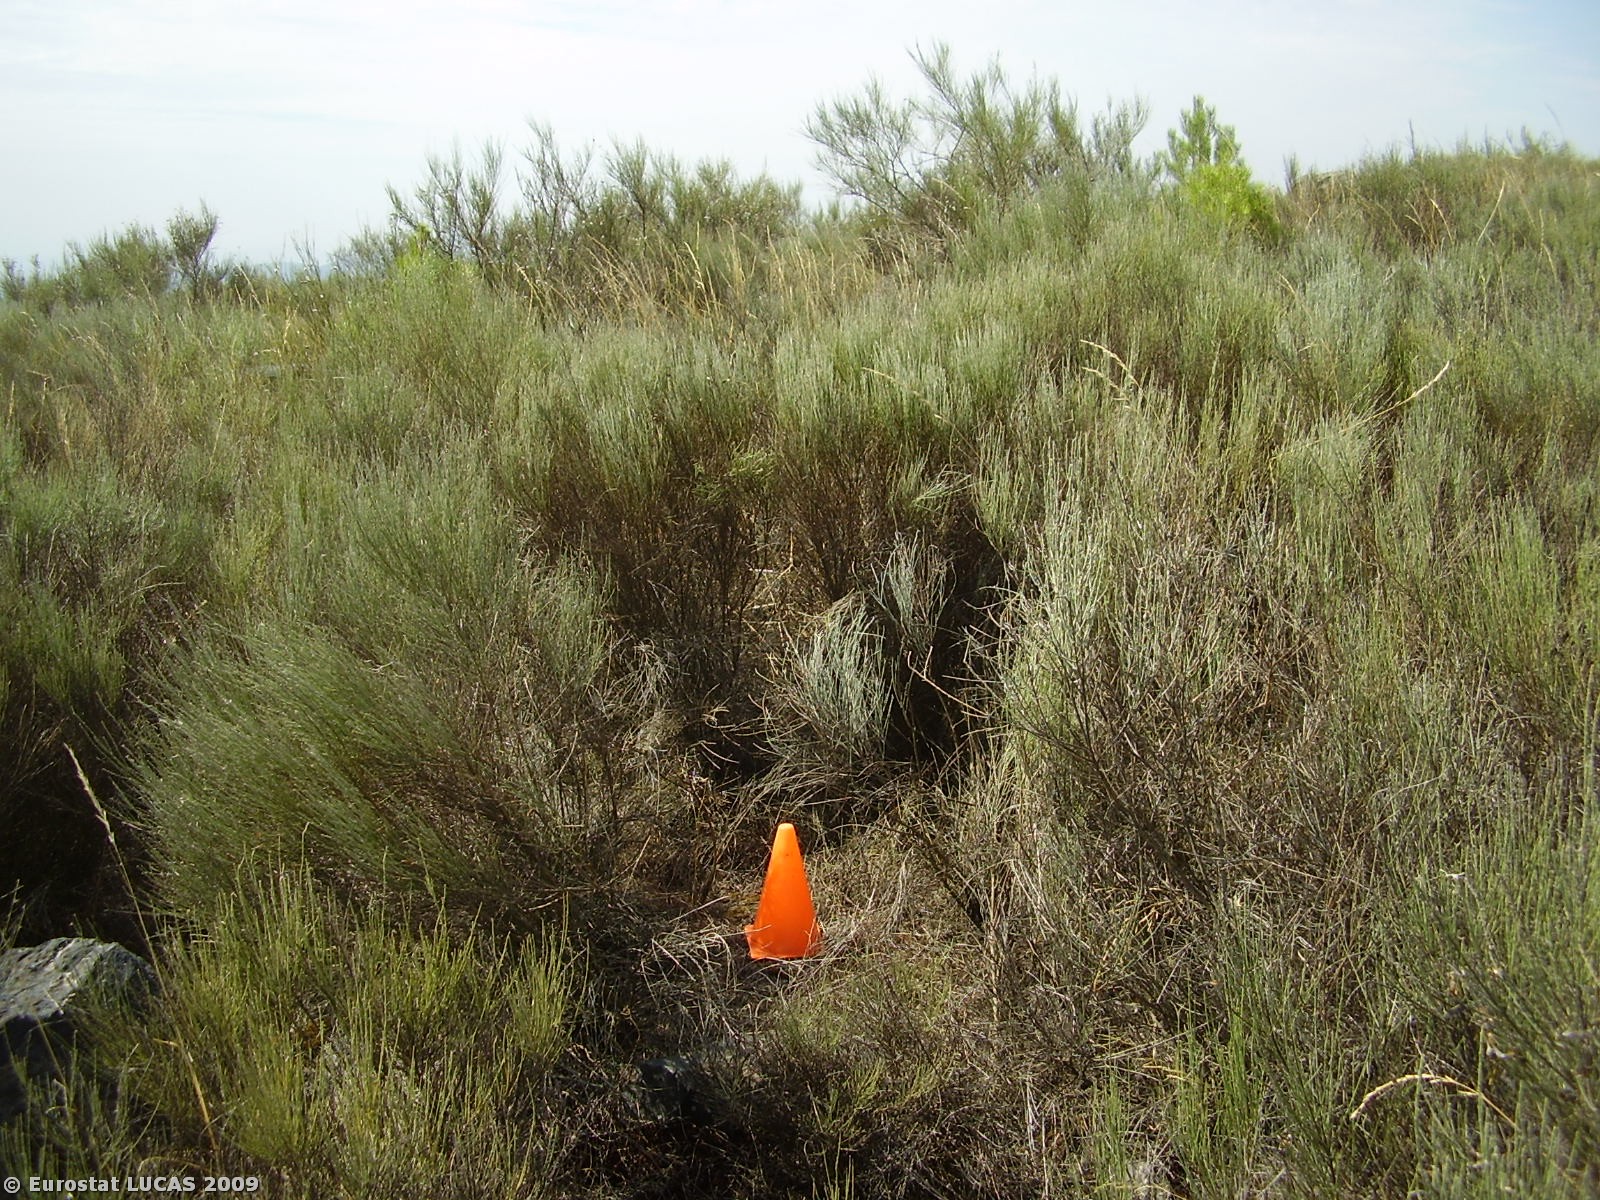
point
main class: Shrubland
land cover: Shrubland with sparse tree cover
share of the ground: > 75 %
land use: Fallow land
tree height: > 5 m
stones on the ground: 25 - 50 %
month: September
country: PT
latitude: 41.1720
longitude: -6.9751
